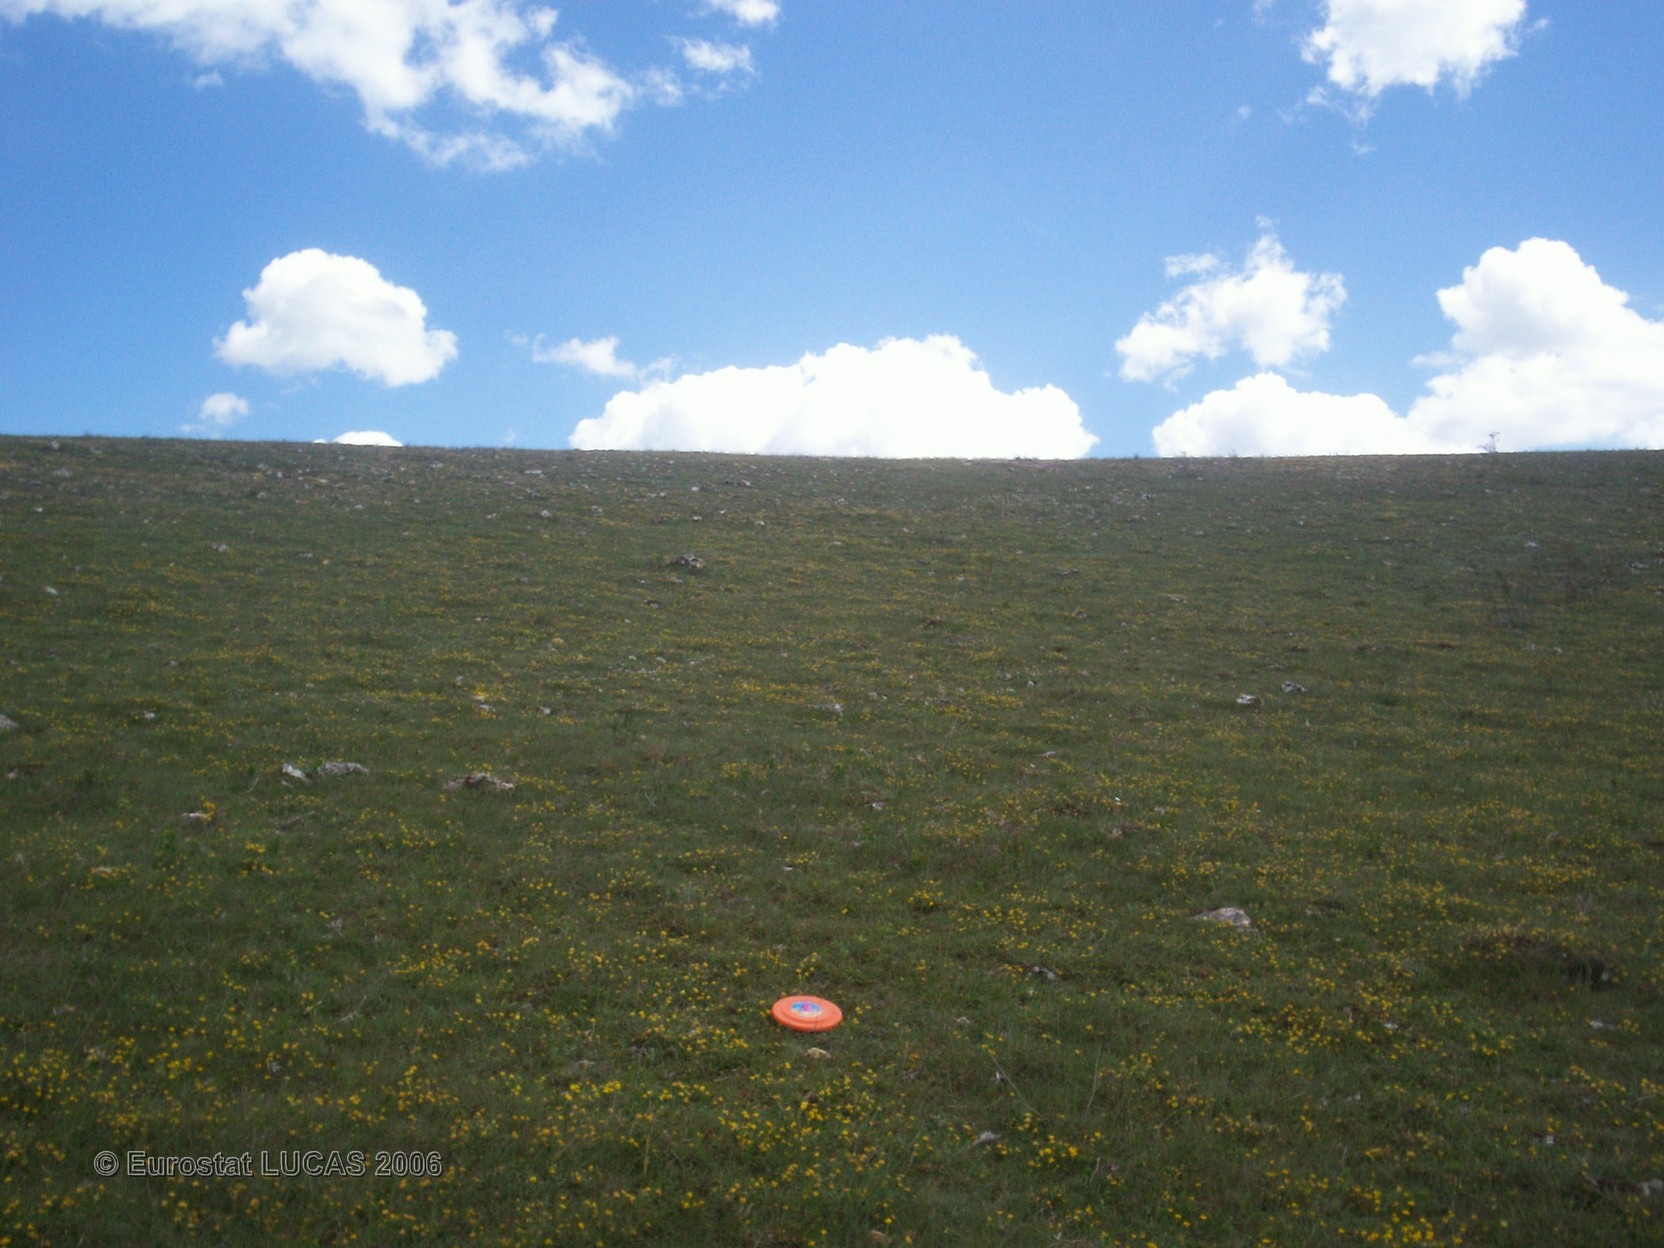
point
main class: Grassland
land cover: Grassland without tree/shrub cover
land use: Agriculture (excluding fallow land and kitchen gardens)
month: June
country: FR
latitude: 44.2329
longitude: 3.4331
